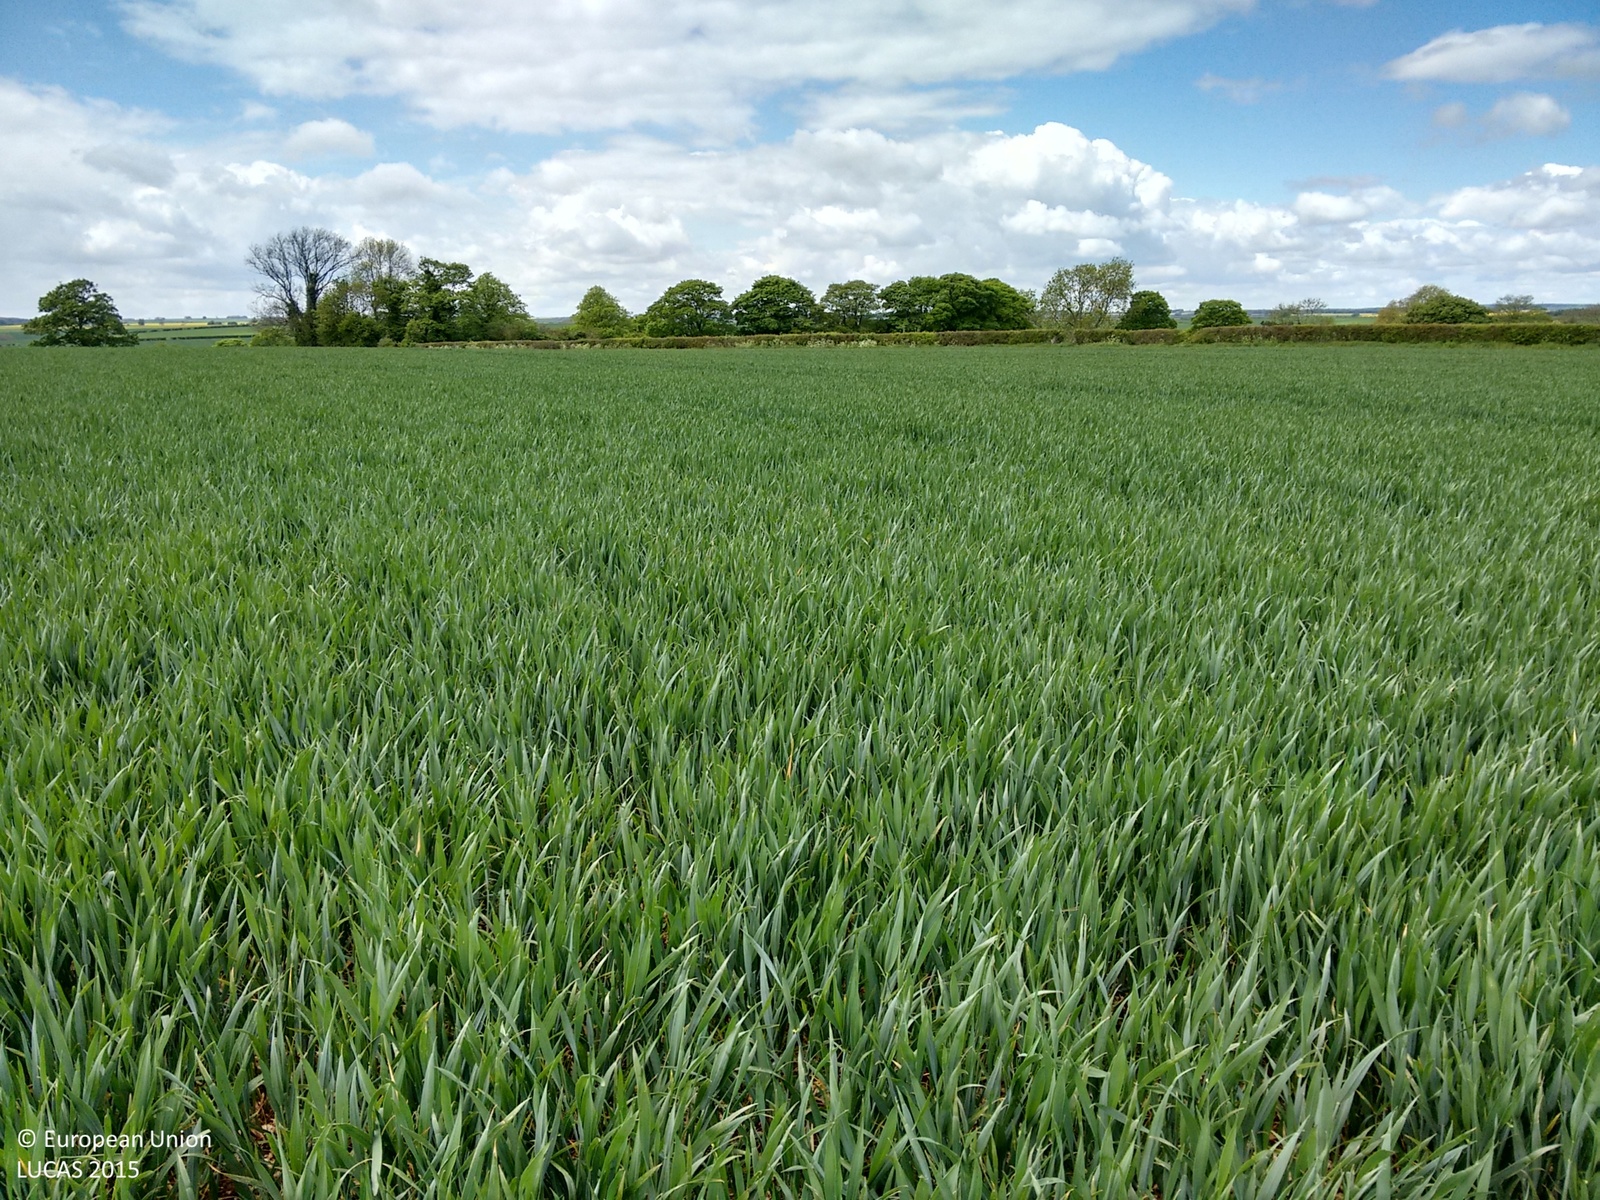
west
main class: Cropland
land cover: Common wheat
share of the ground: > 75 %
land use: Agriculture (excluding fallow land and kitchen gardens)
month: May
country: GB
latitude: 53.4620
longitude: -0.1703
